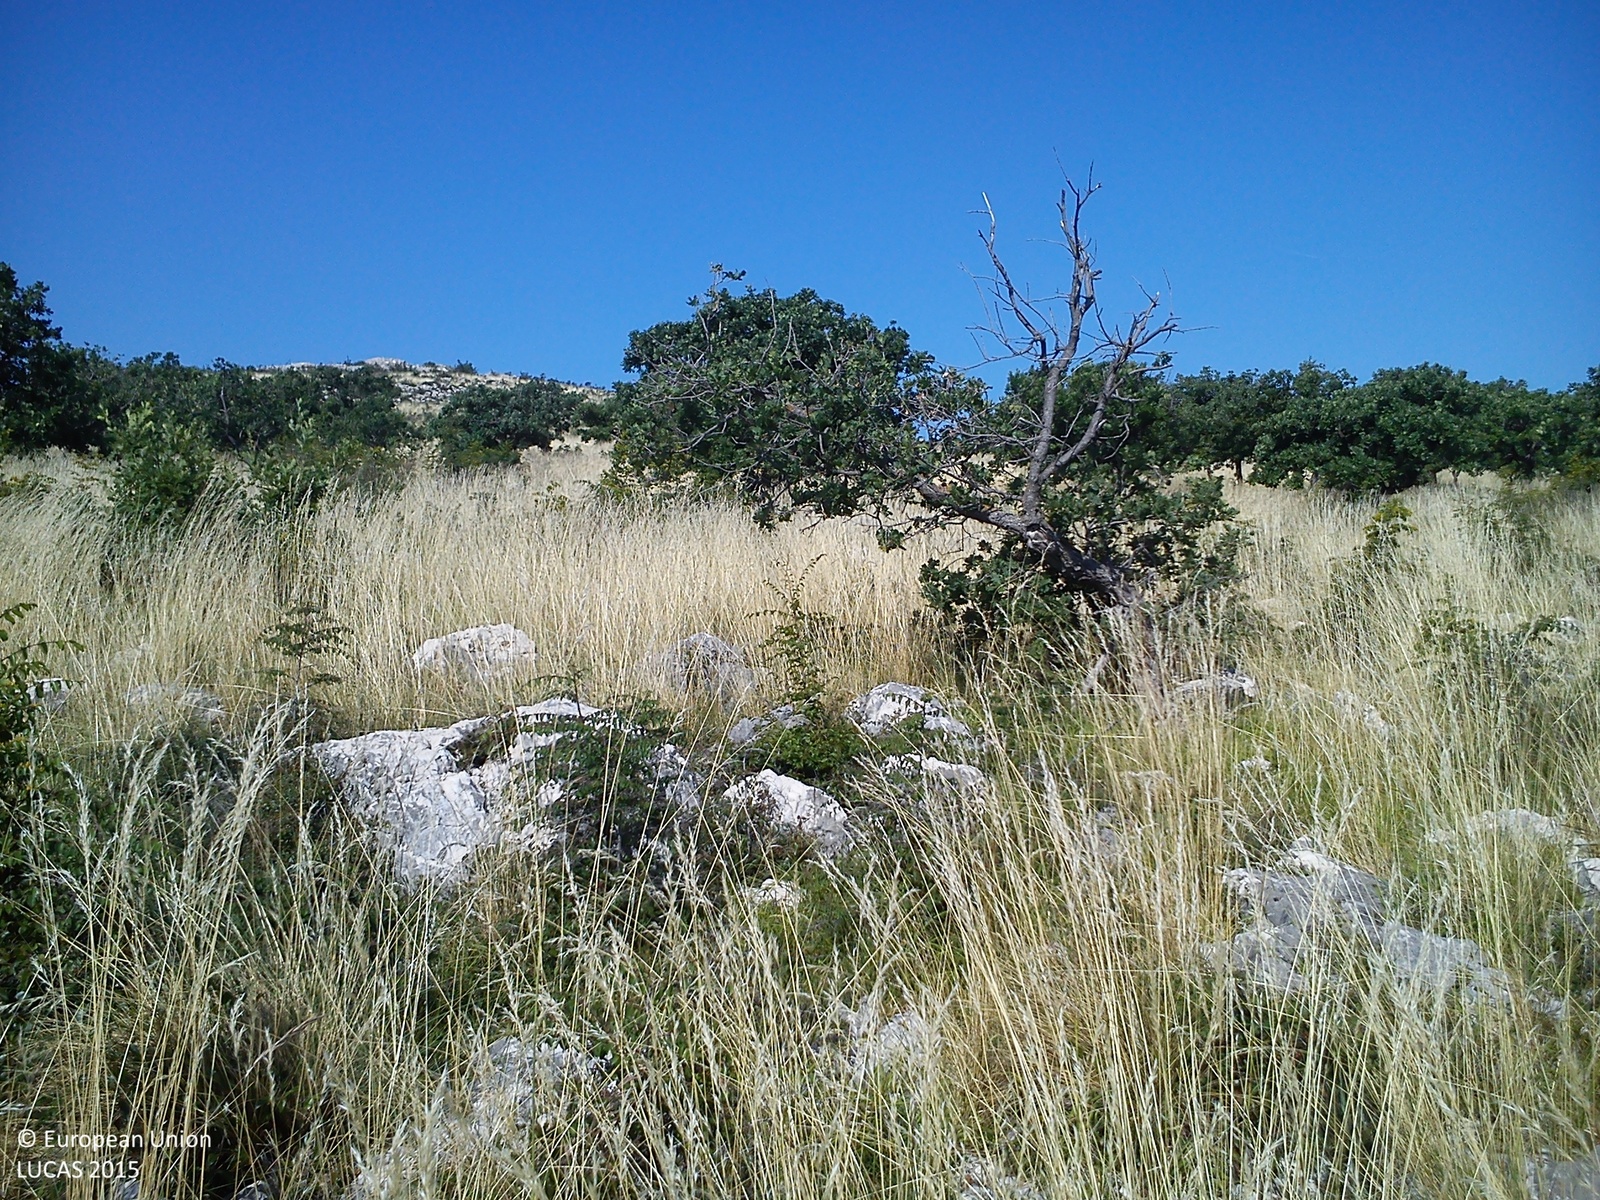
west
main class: Grassland
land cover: Grassland with sparse tree/shrub cover
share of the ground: > 75 %
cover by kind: herbaceous plants 60 %, unconsolidated bare surface 25 %, shrubs 10 %, coniferous forest trees 5 %
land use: Semi-natural and natural areas not in use
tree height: < 5 m
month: June
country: HR
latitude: 44.1875
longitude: 15.4843
